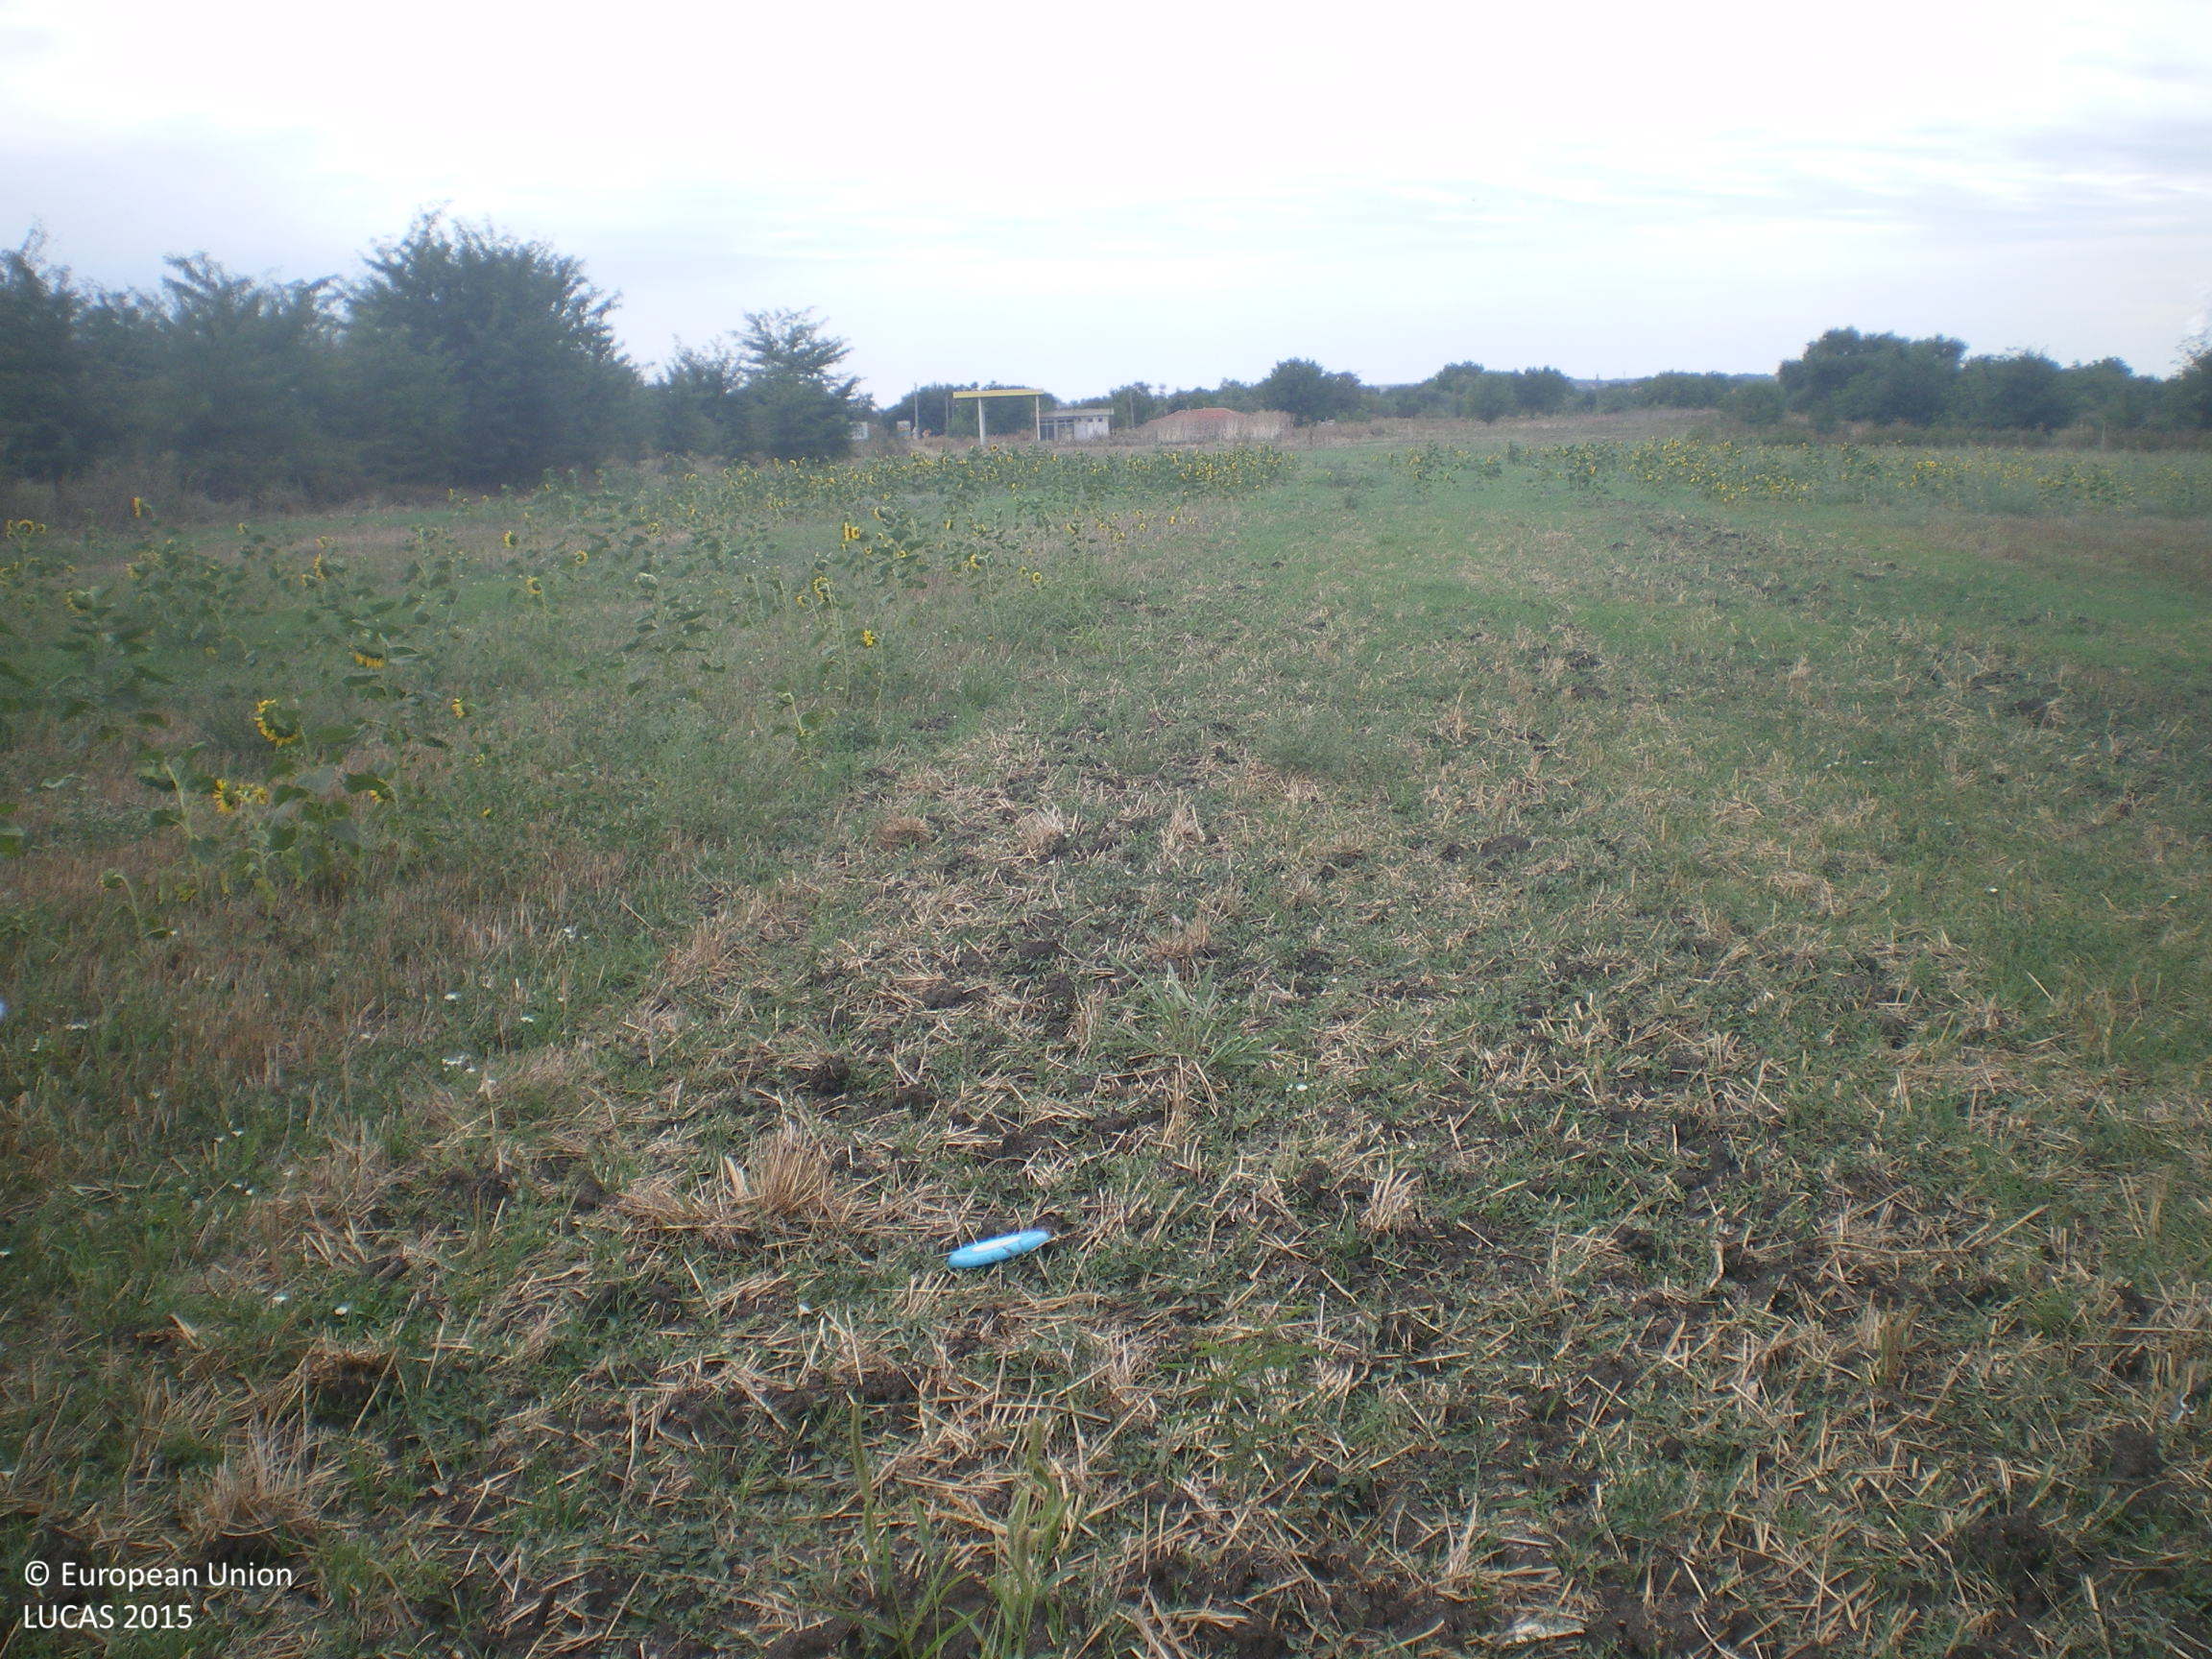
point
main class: Cropland
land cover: Common wheat
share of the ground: < 10 %
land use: Agriculture (excluding fallow land and kitchen gardens)
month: September
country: BG
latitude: 42.2456
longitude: 25.9408
